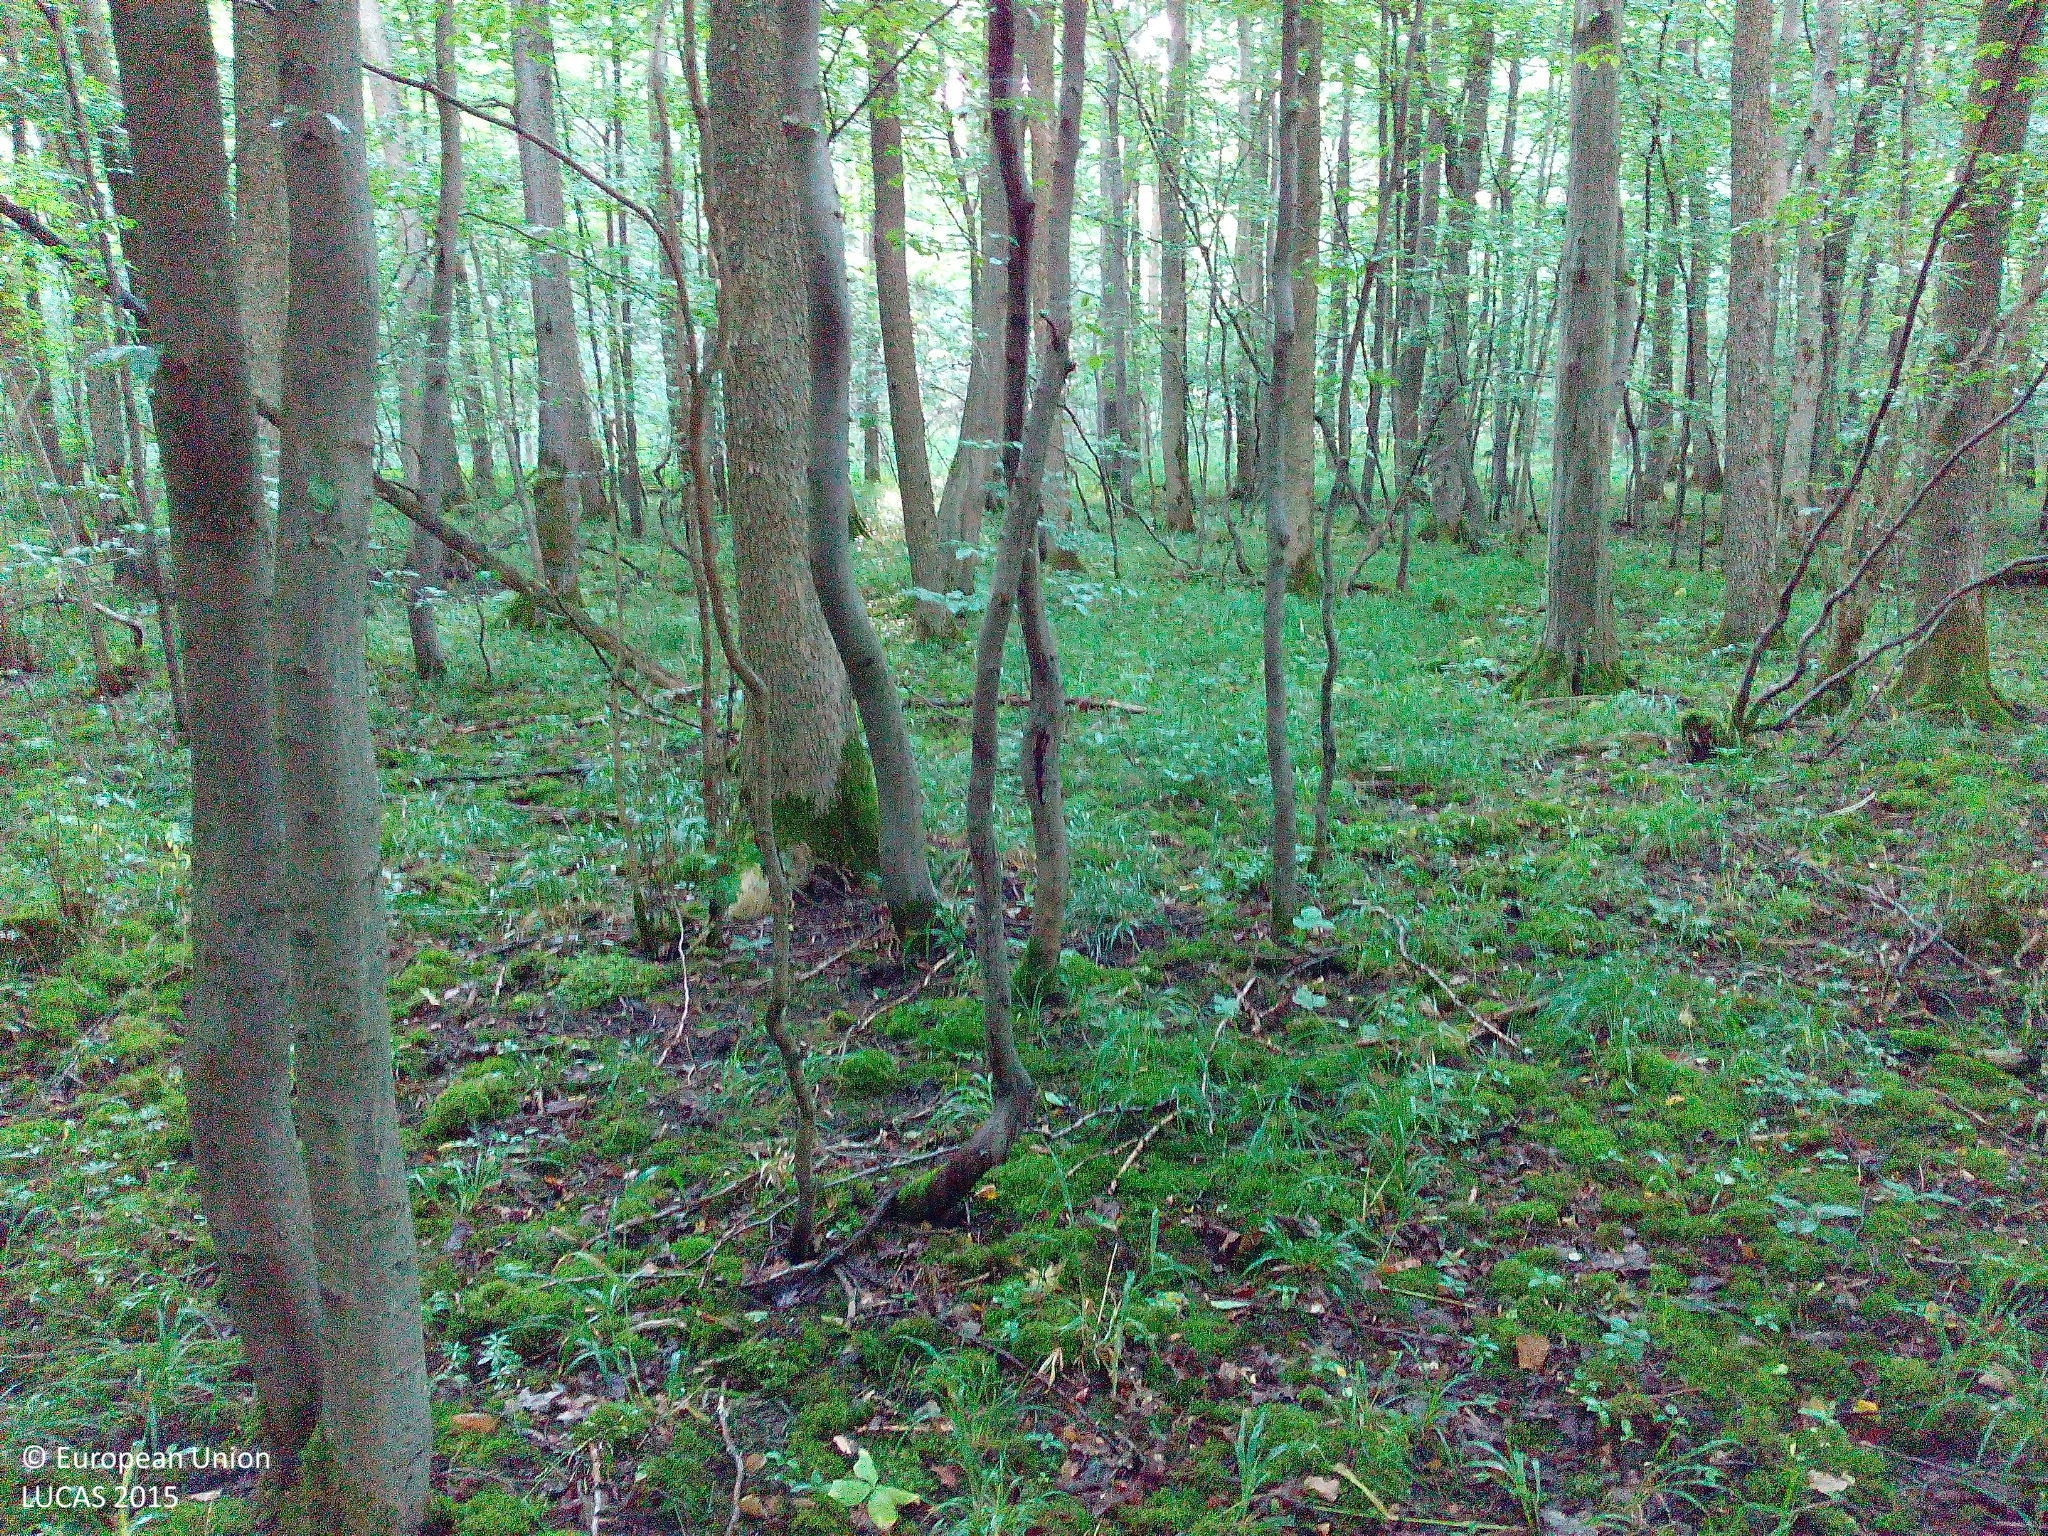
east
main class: Woodland
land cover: Broadleaved woodland
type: acidophilous oak and oak-birch forest
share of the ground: > 75 %
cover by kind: broadleaved forest trees 100 %
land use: Forestry
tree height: > 5 m
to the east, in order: Broadleaved woodland; Spruce dominated mixed woodland
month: July
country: DE
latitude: 50.6696
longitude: 9.8727
